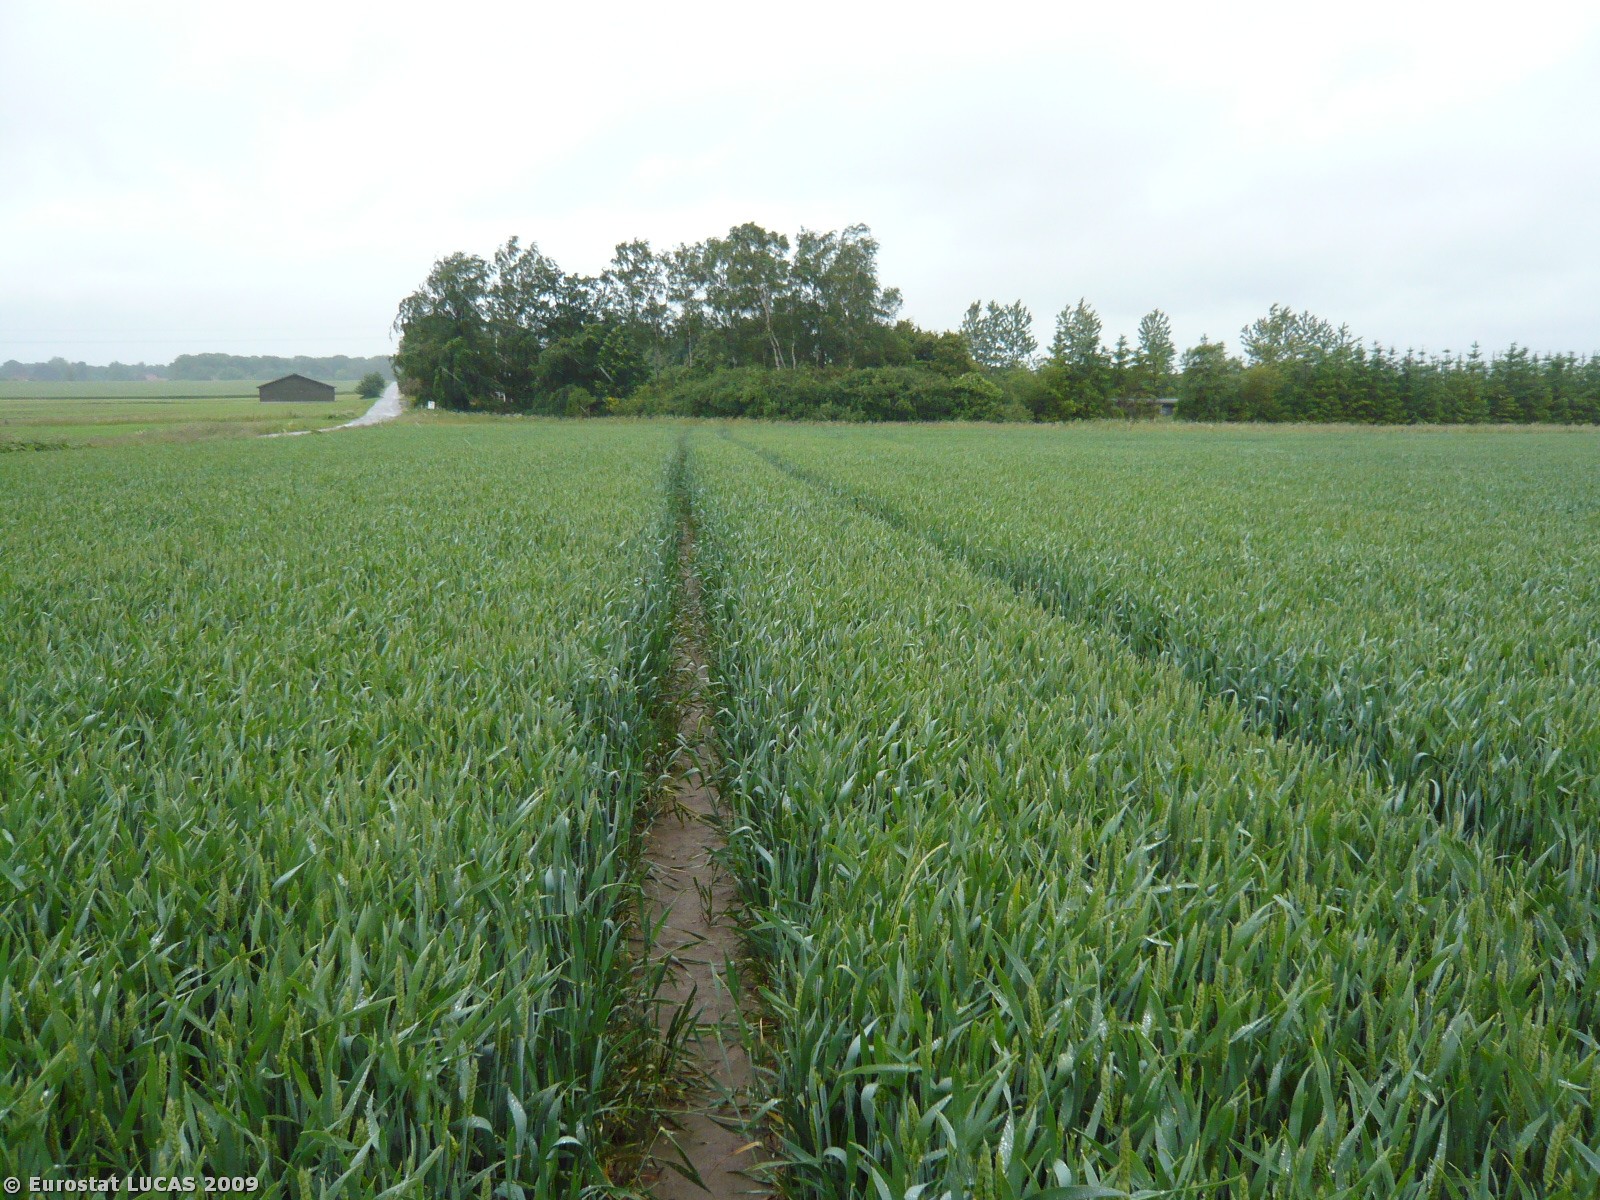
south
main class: Cropland
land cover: Common wheat
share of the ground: > 75 %
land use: Agriculture (excluding fallow land and kitchen gardens)
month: June
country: DK
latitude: 54.7707
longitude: 11.9418
